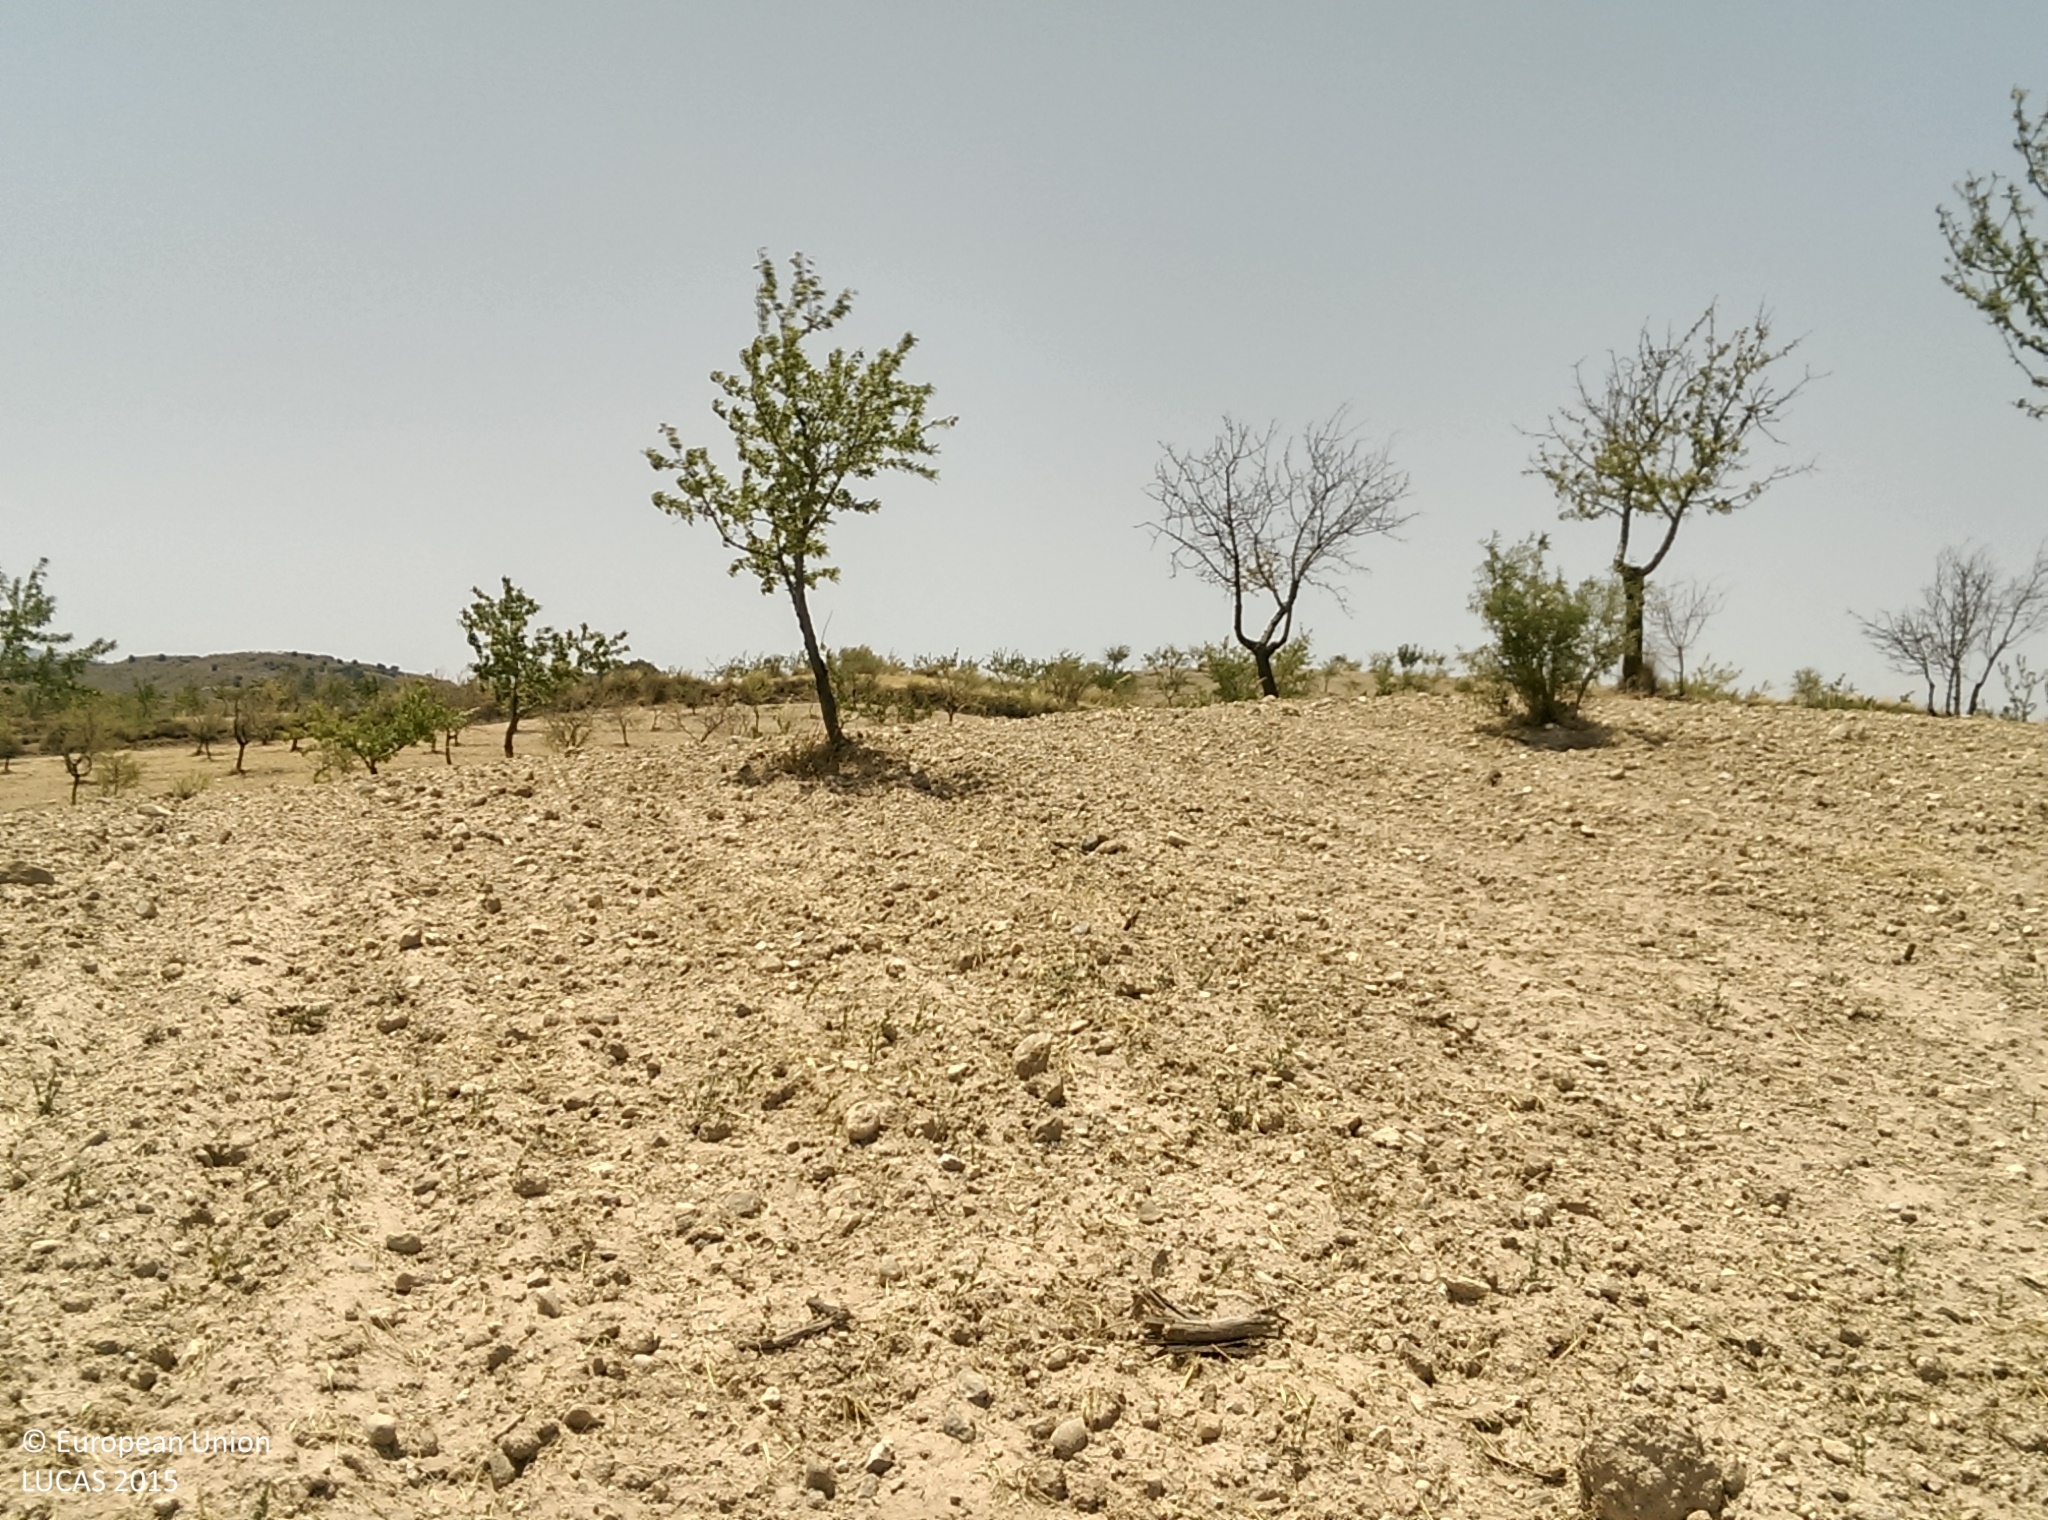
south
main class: Cropland
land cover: Nuts trees
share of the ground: < 10 %
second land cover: Other bare soil
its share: > 75 %
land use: Agriculture (excluding fallow land and kitchen gardens)
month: July
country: ES
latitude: 37.5222
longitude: -2.9216
